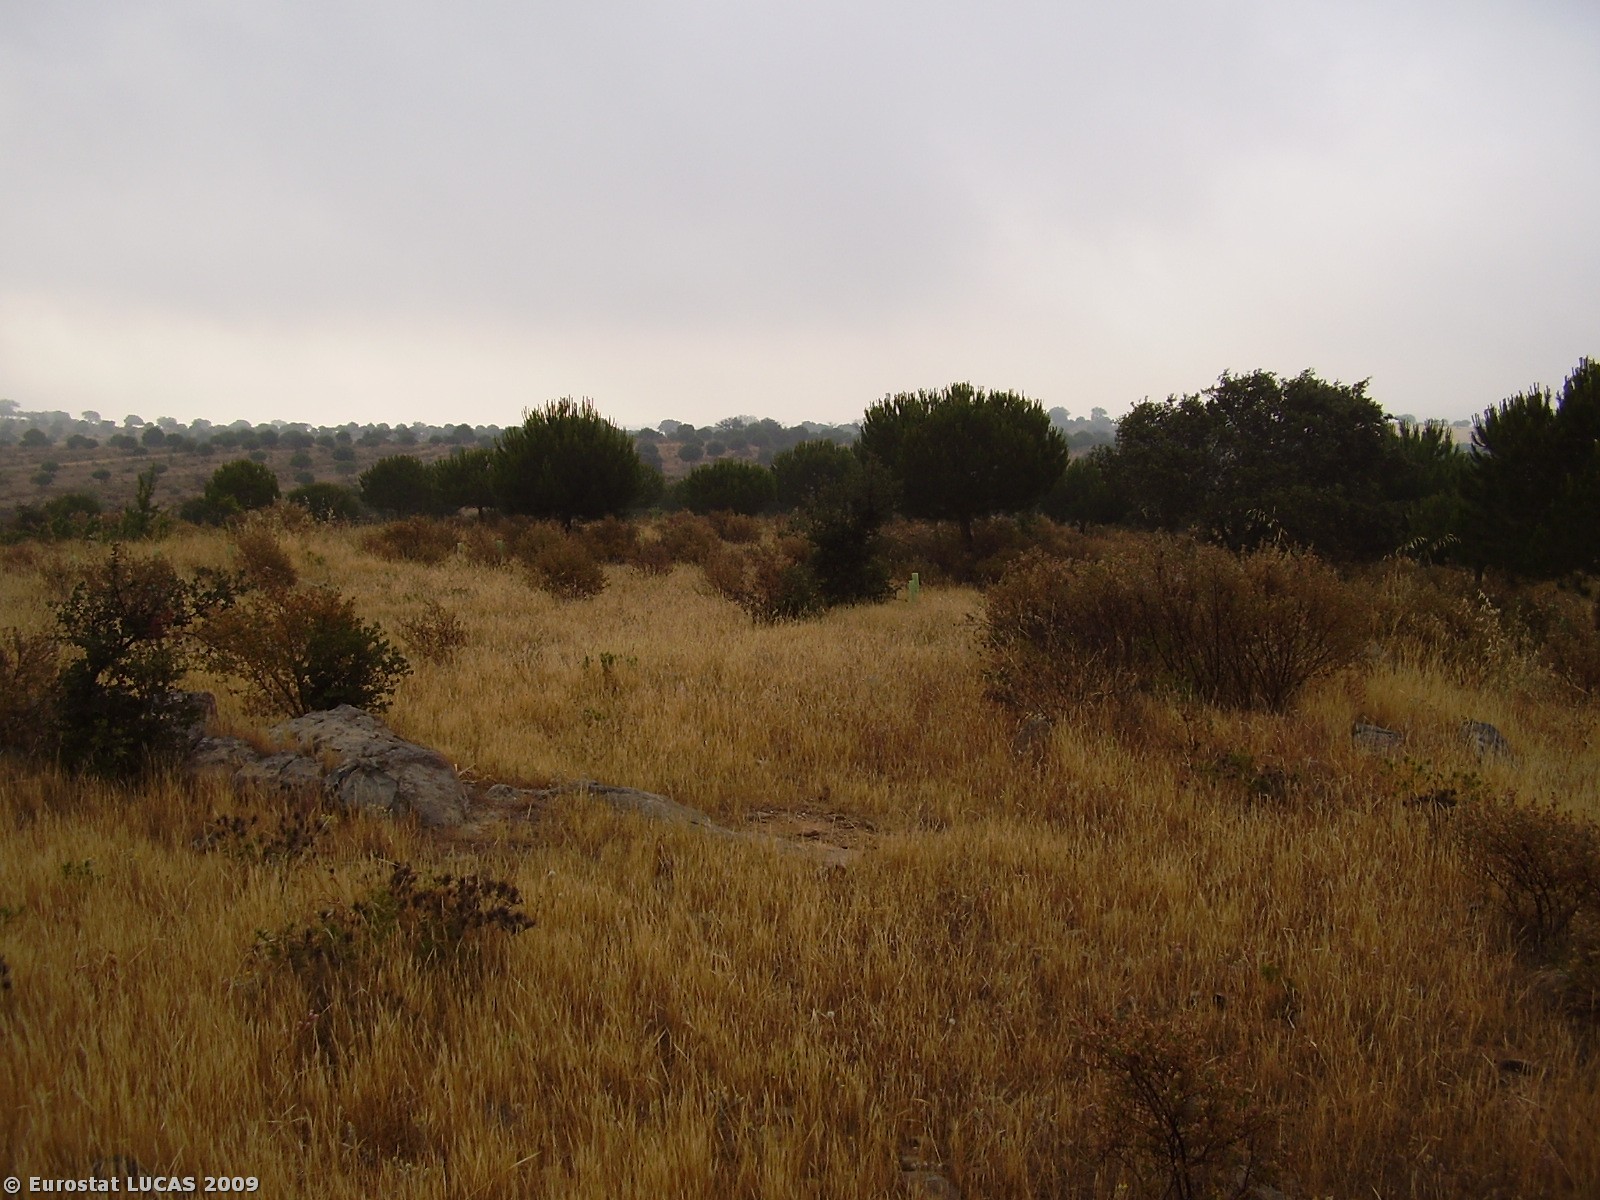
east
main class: Woodland
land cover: Mixed woodland
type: coniferous forest of the mediterranean region
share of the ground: 25 - 50 %
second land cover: Spontaneously vegetated surfaces
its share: 50 - 75 %
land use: Forestry
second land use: Fallow land
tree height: > 5 m
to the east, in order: Mixed woodland; Rivers and streams; Mixed woodland; Rivers and streams; Mixed woodland
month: May
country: PT
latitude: 37.6160
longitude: -7.5617
